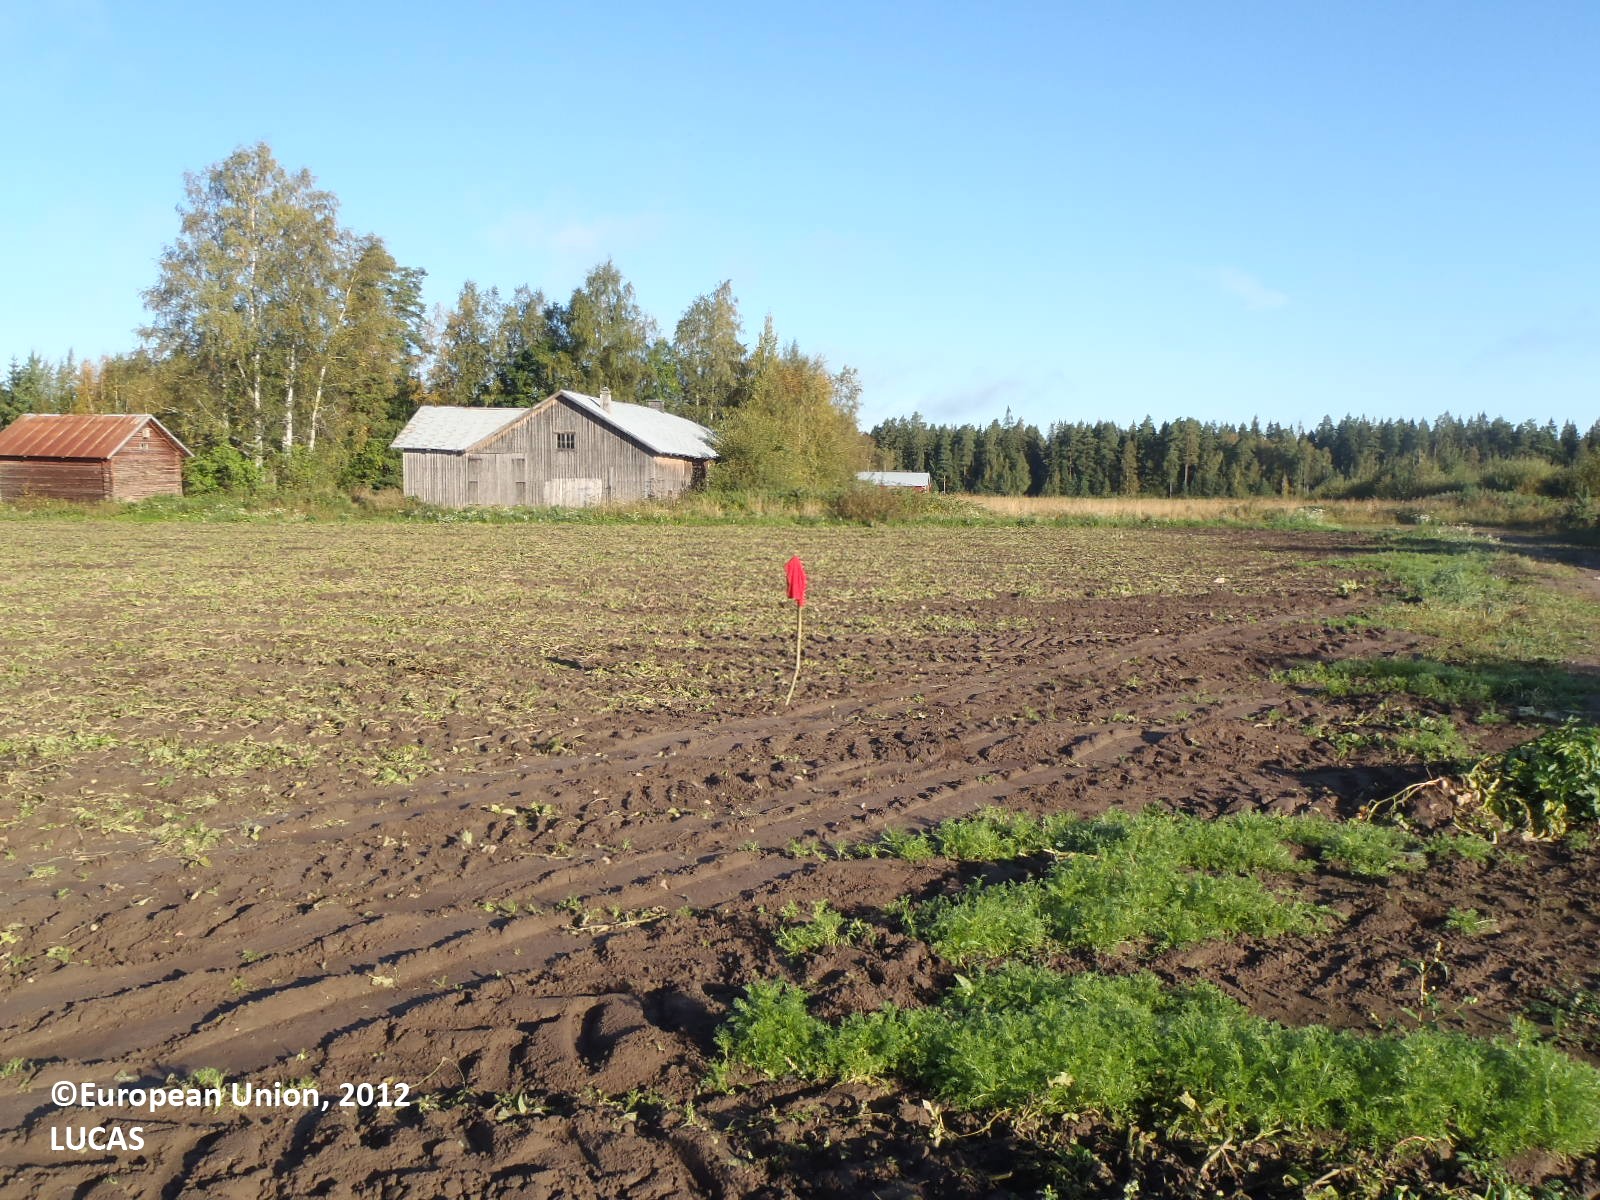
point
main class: Cropland
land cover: Potatoes
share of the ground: 50 - 75 %
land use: Agriculture (excluding fallow land and kitchen gardens)
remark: Harvested field
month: September
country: FI
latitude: 61.0537
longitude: 22.4197
